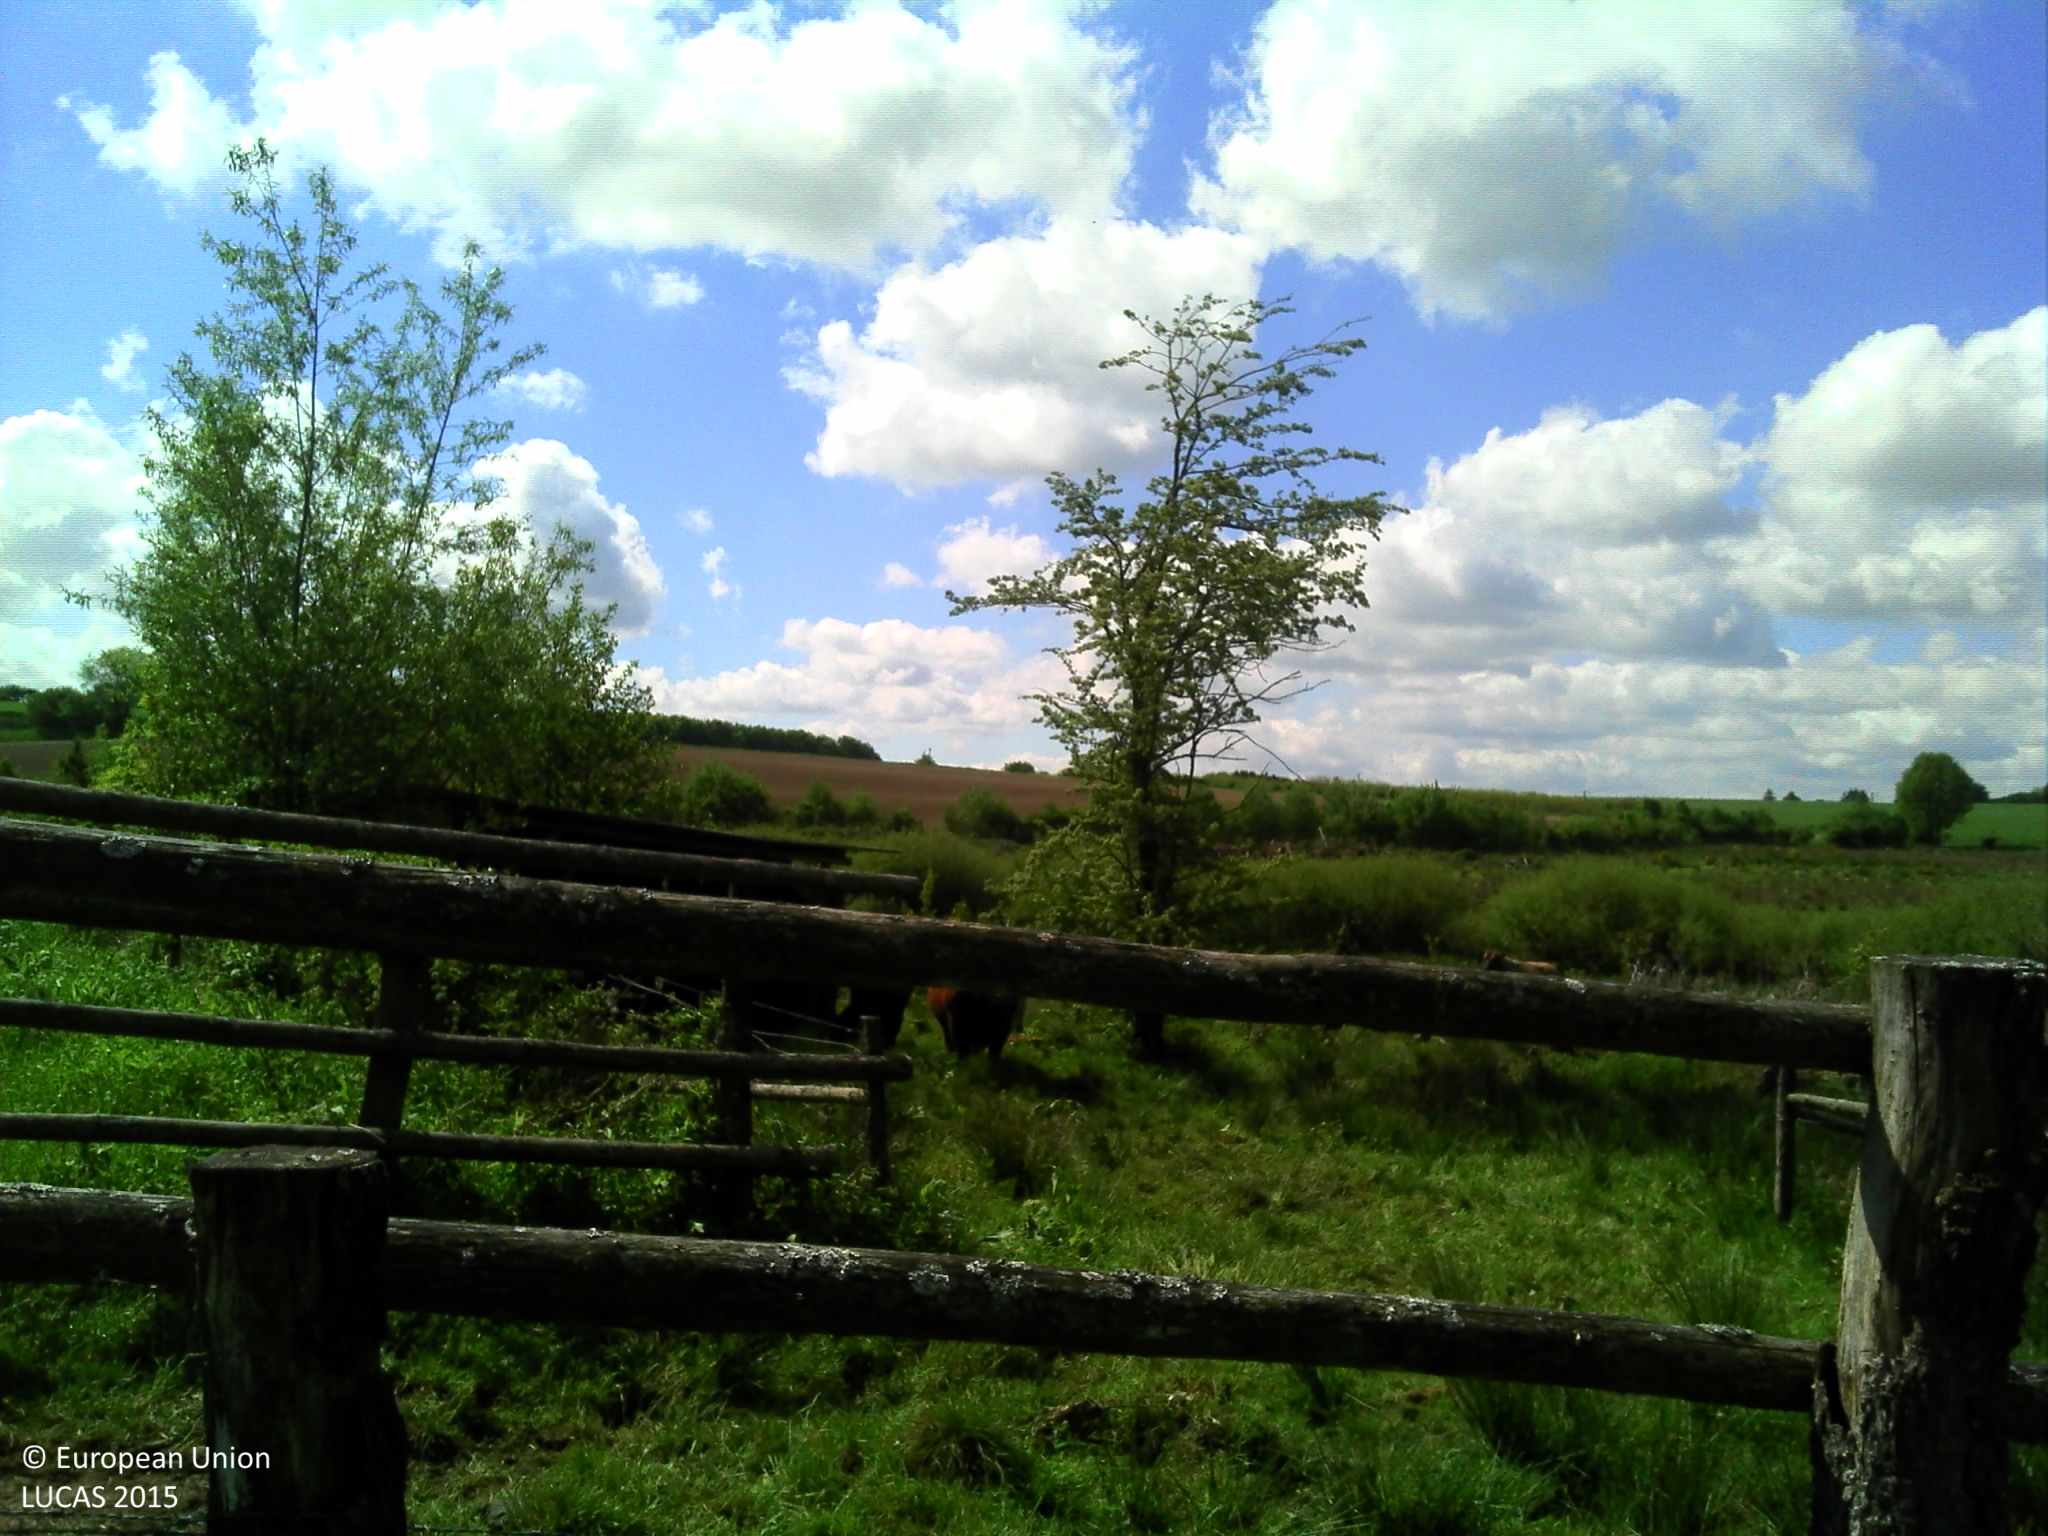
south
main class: Grassland
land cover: Grassland with sparse tree/shrub cover
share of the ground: > 75 %
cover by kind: herbaceous plants 95 %, broadleaved forest trees 5 %
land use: Agriculture (excluding fallow land and kitchen gardens)
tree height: > 5 m
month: May
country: LU
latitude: 50.1675
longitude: 5.9811
